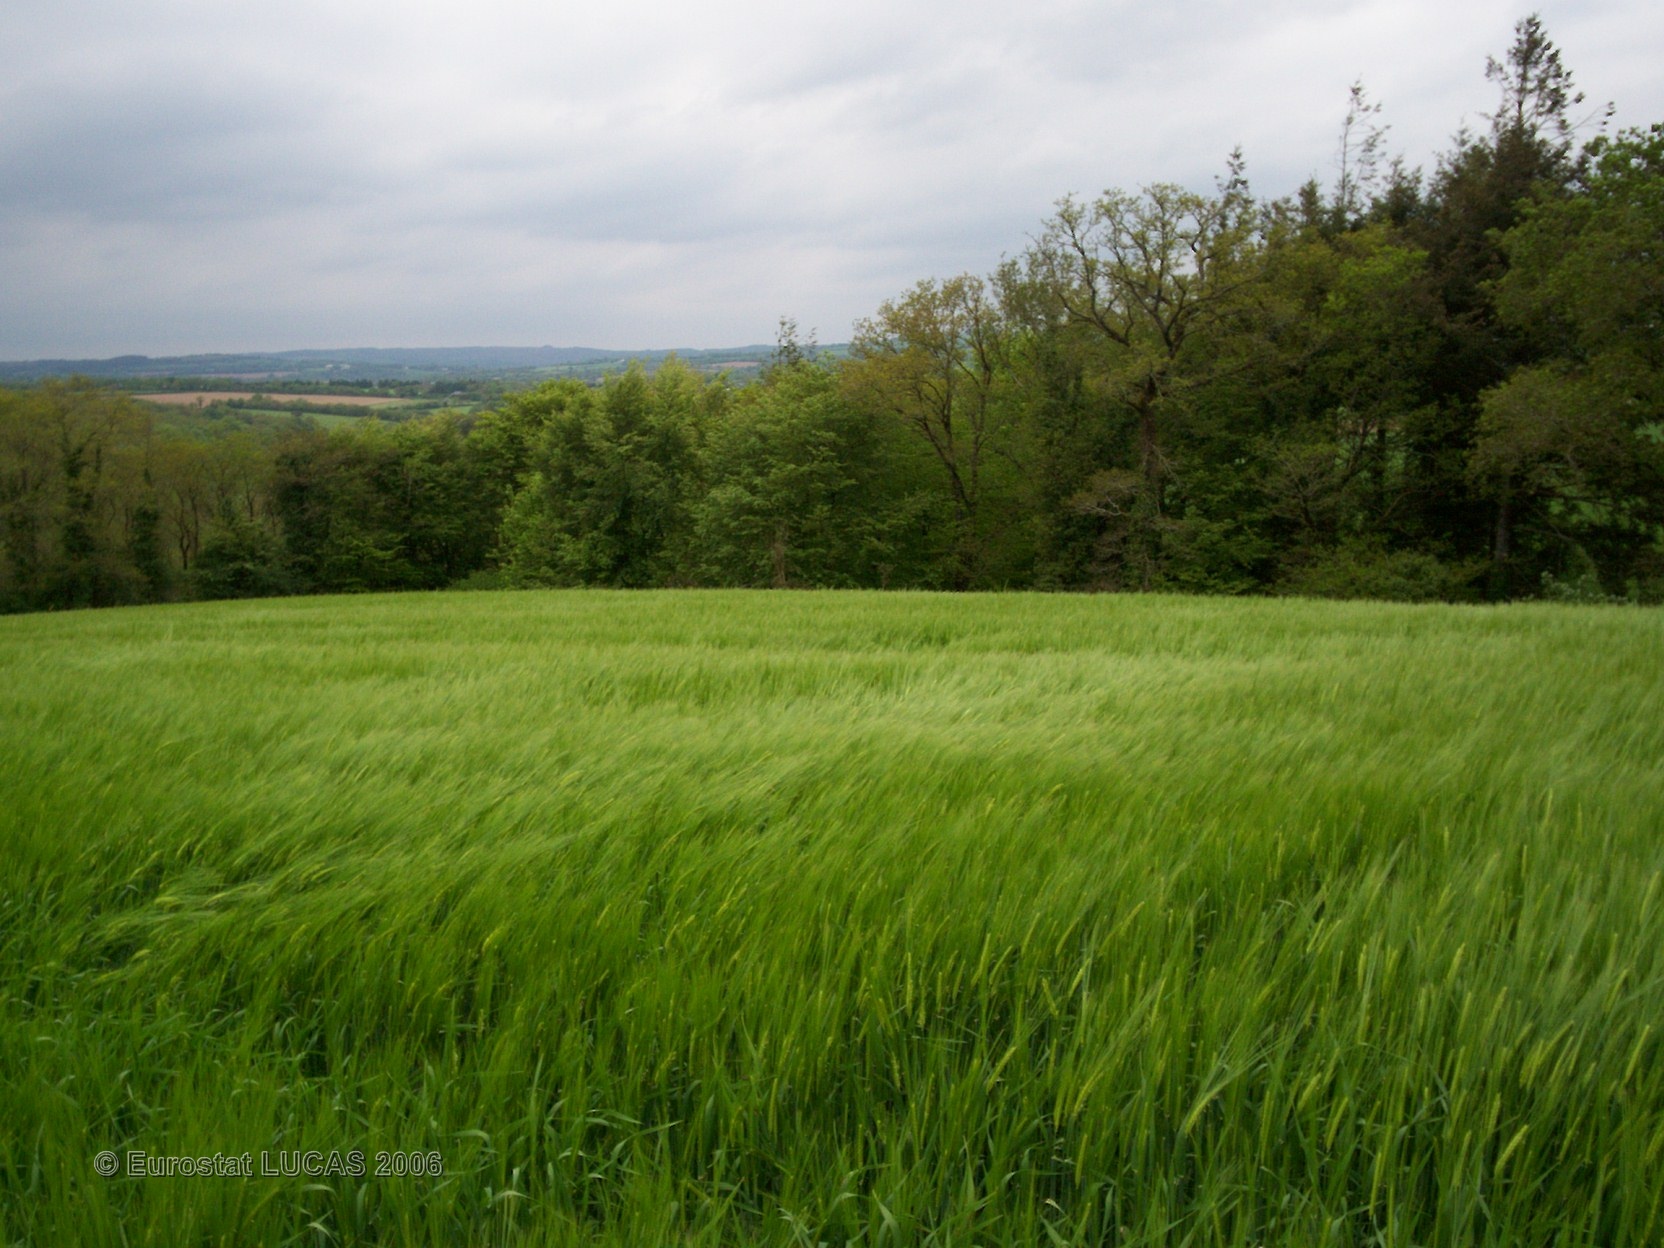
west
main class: Cropland
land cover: Barley
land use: Agriculture (excluding fallow land and kitchen gardens)
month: May
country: FR
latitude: 48.2927
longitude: -3.7092
